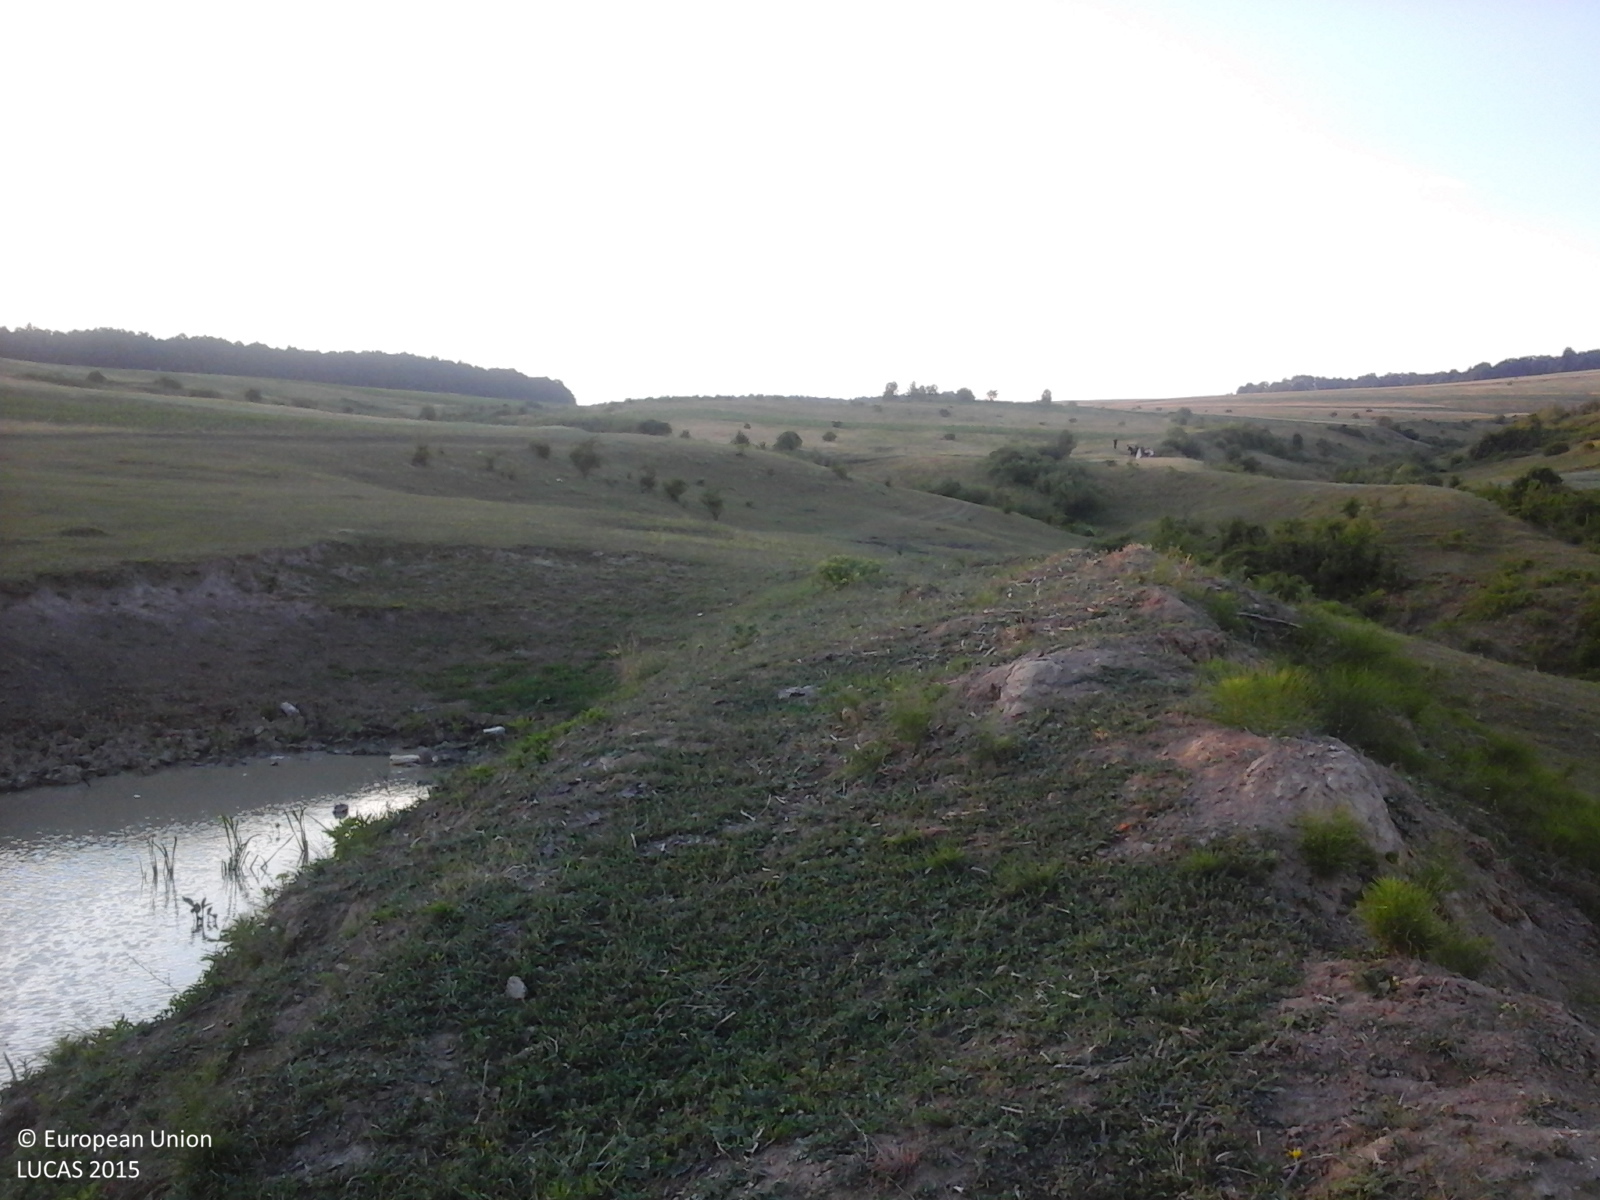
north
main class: Grassland
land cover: Grassland without tree/shrub cover
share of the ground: > 75 %
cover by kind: herbaceous plants 100 %
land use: Agriculture (excluding fallow land and kitchen gardens)
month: June
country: RO
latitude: 46.9675
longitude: 27.2047
